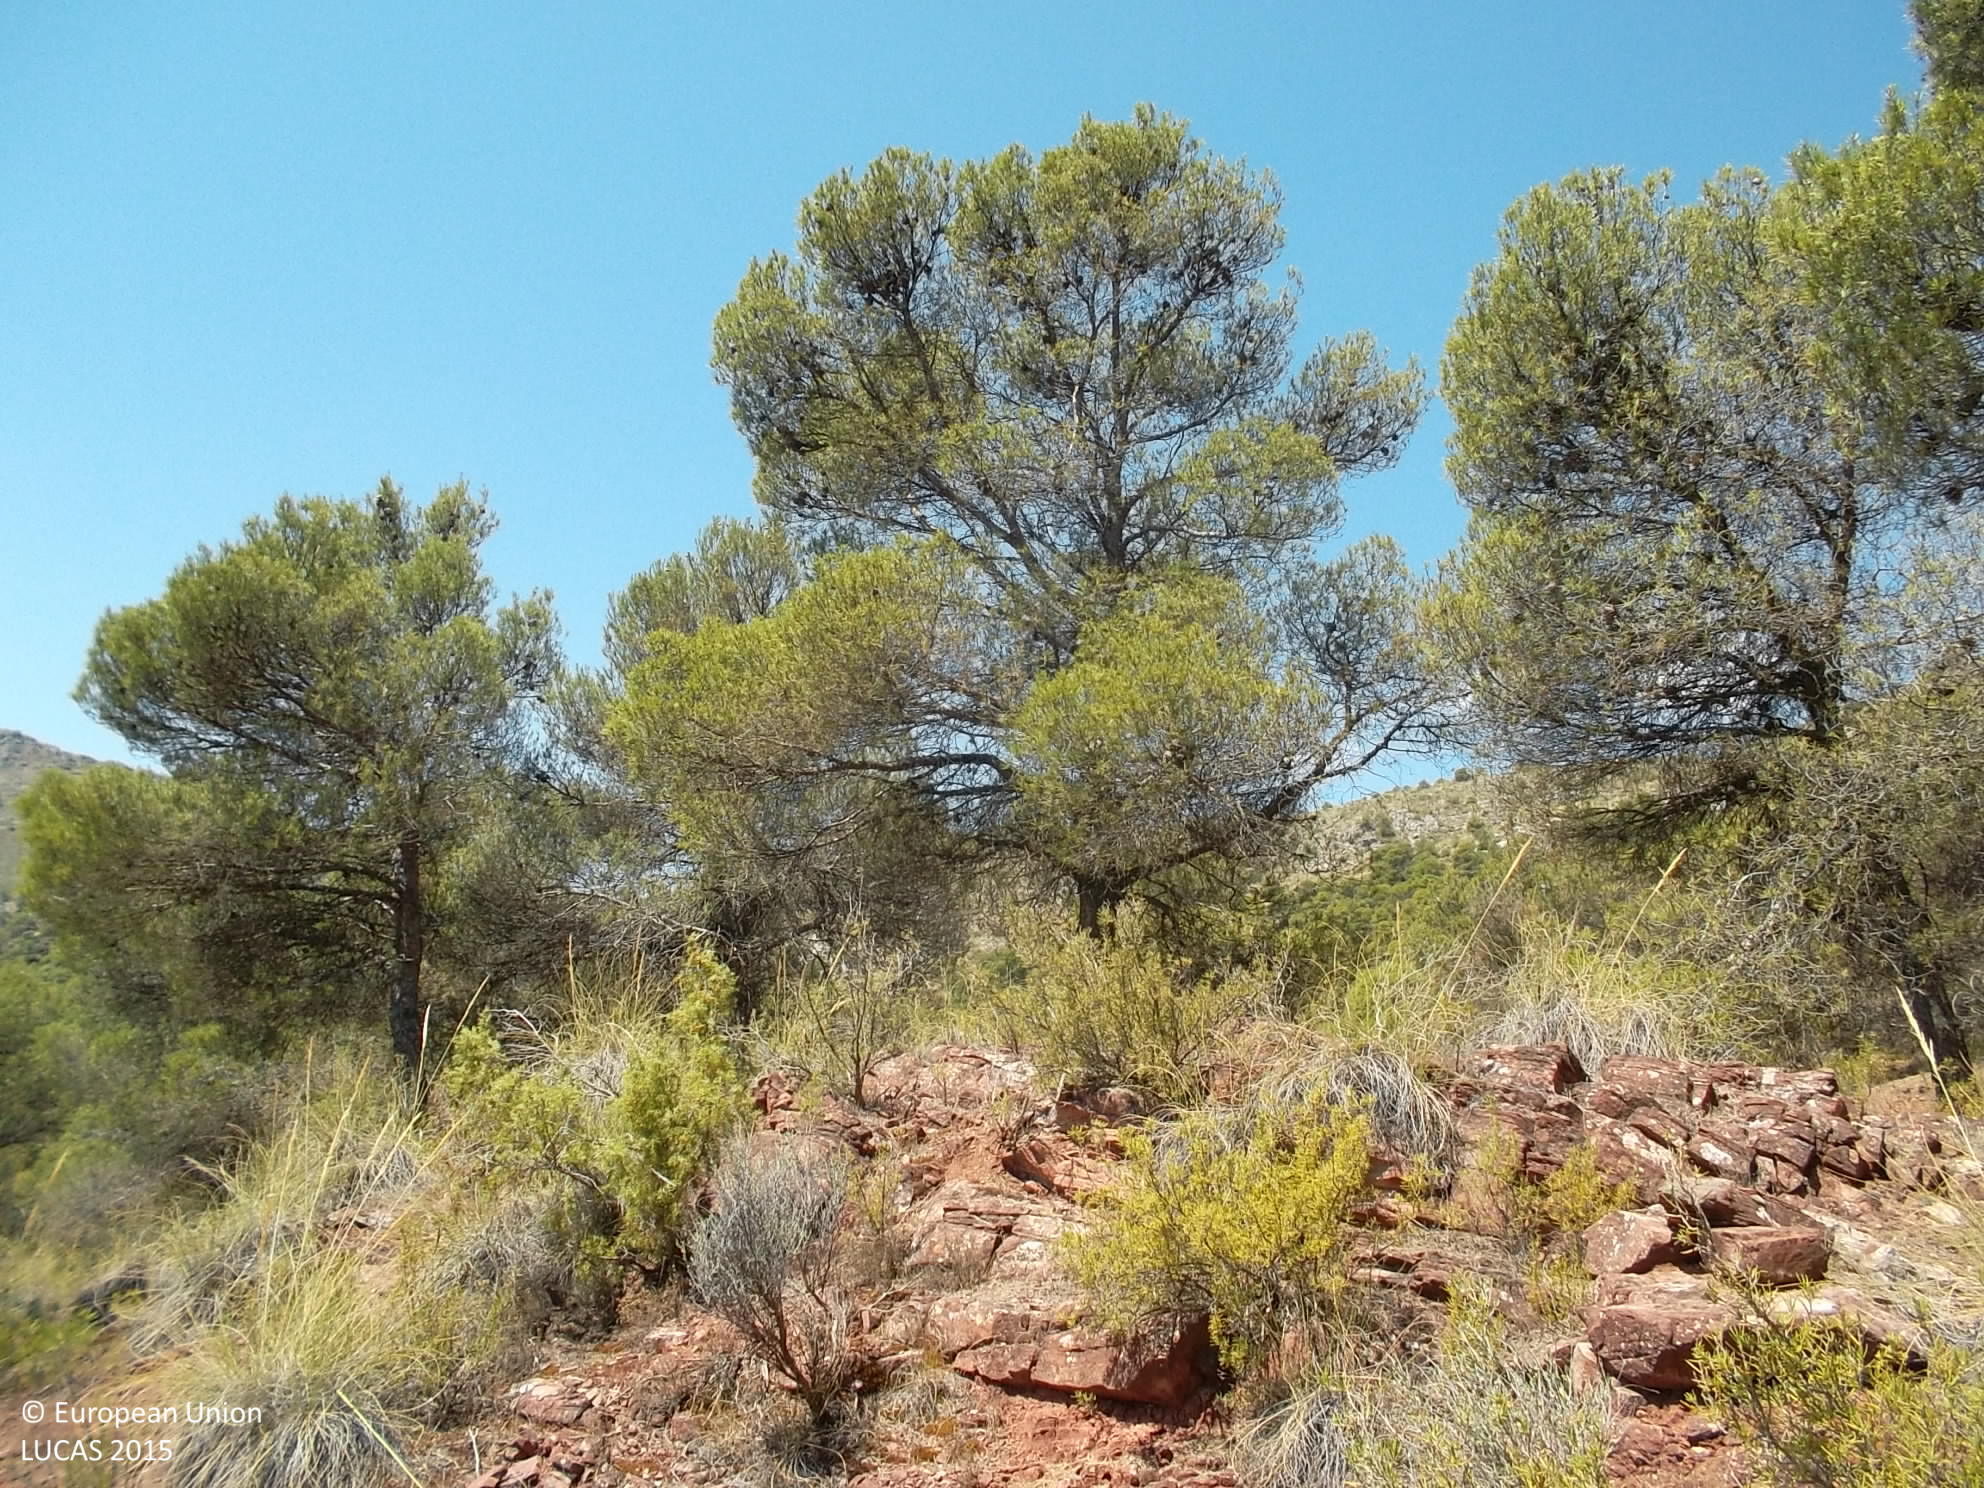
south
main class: Woodland
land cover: Pine dominated coniferous woodland
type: coniferous forest of the mediterranean region
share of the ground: 50 - 75 %
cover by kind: coniferous forest trees 40 %, shrubs 30 %, consolidated bare surface 20 %, herbaceous plants 10 %
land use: Forestry
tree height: > 5 m
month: June
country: ES
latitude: 37.6900
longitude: -3.2967
